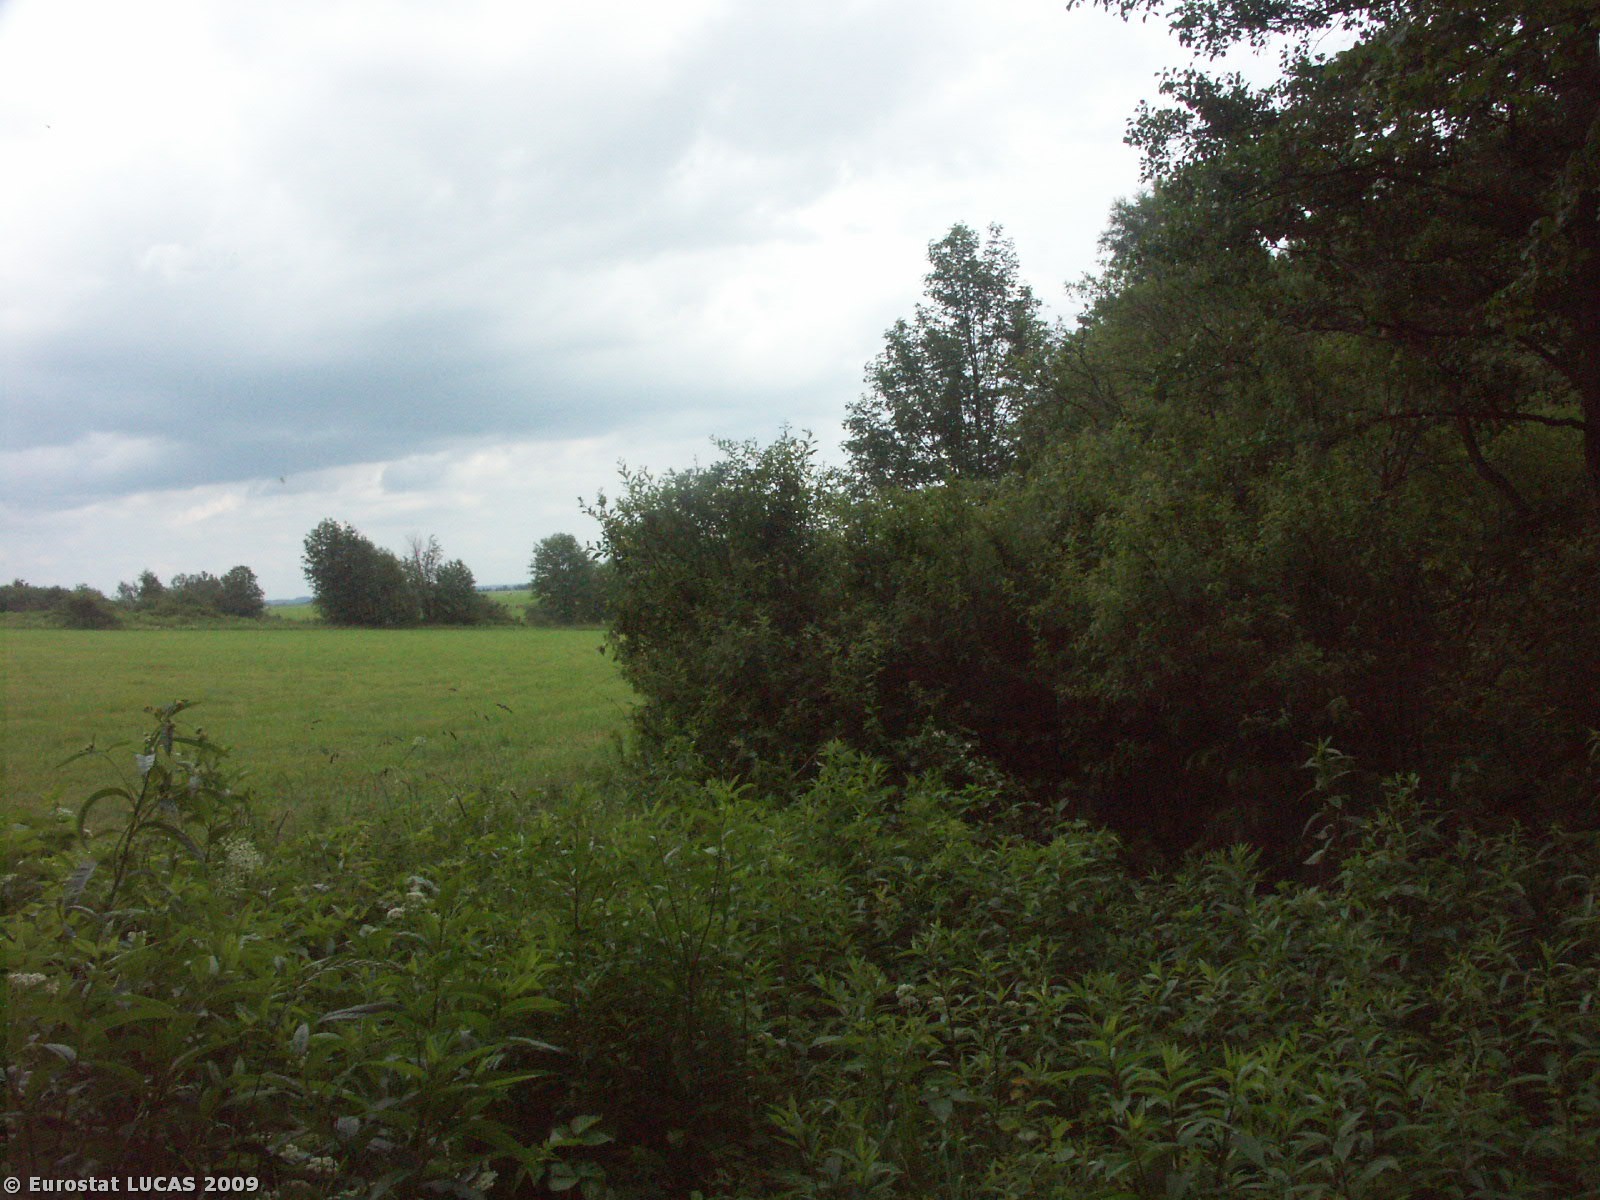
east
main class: Woodland
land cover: Broadleaved woodland
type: mesophytic deciduous forest
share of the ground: > 75 %
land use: Forestry
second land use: Nature reserves
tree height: > 5 m
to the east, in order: Broadleaved woodland; Grassland without tree/shrub cover; Broadleaved woodland; Grassland without tree/shrub cover
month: July
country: CZ
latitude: 49.9197
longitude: 17.2115
